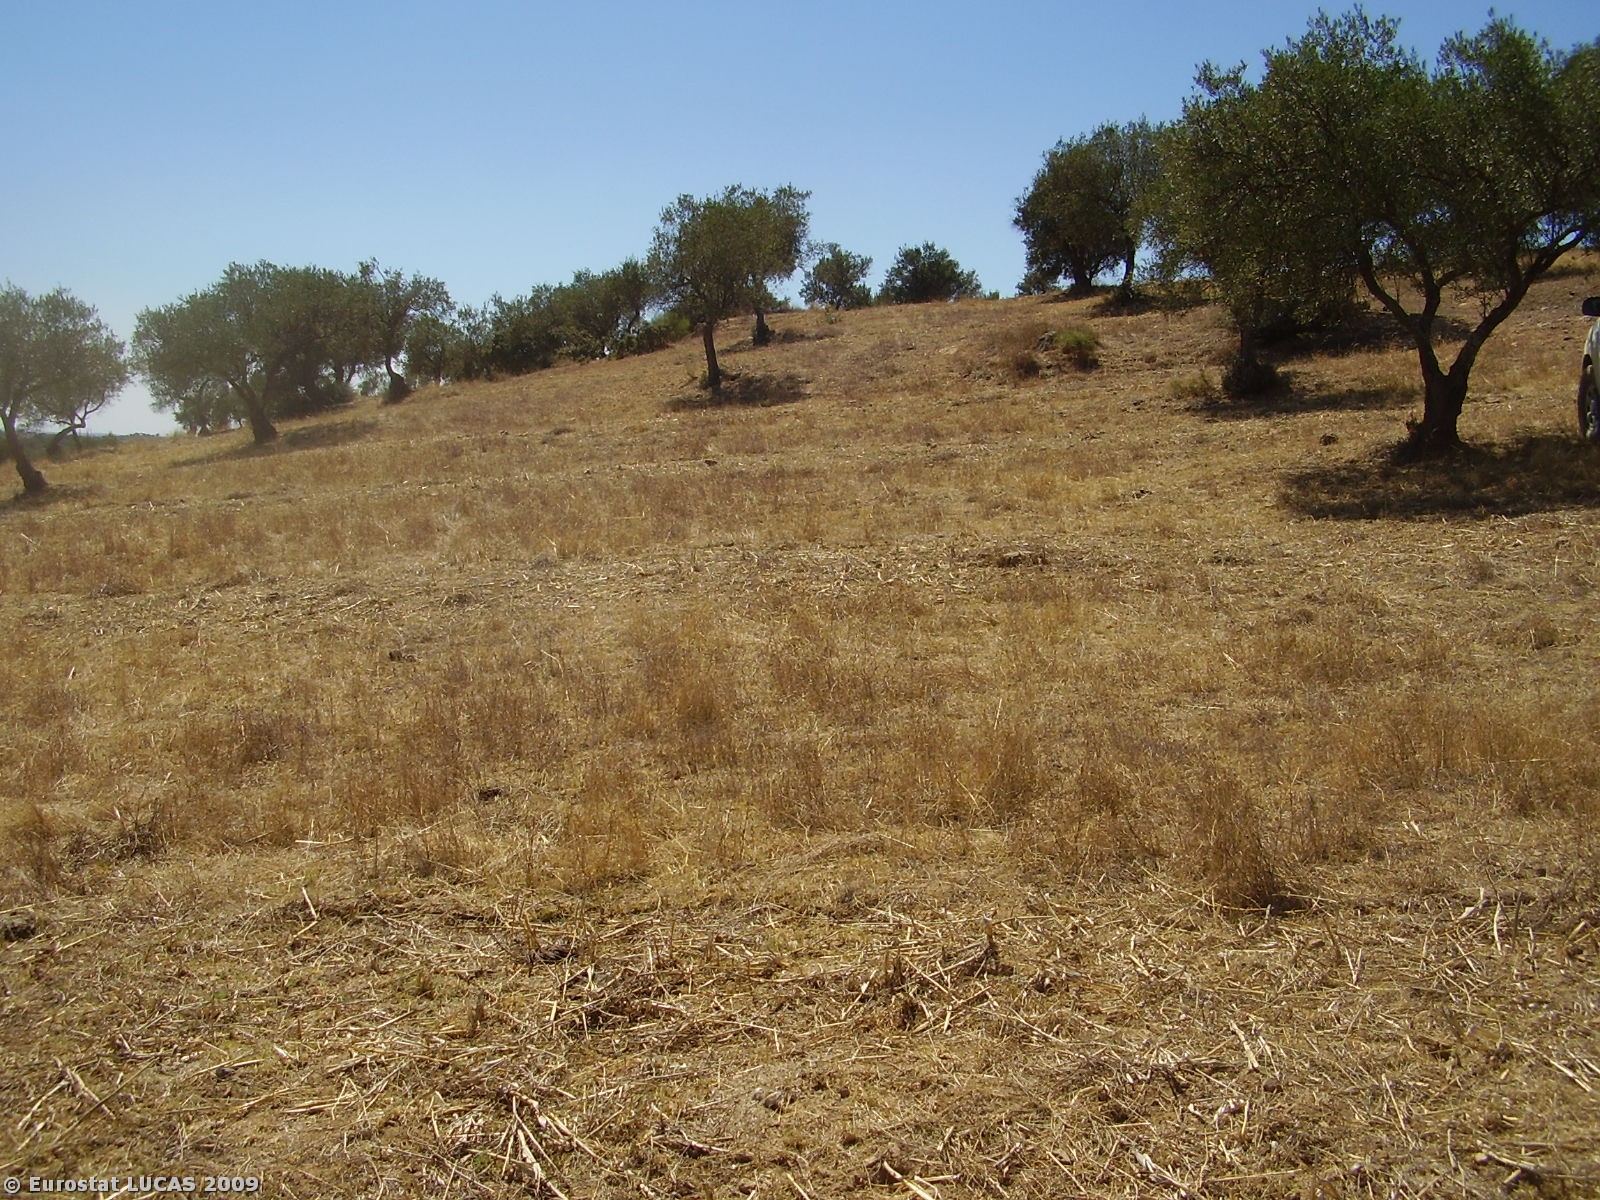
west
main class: Cropland
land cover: Olive groves
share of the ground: 25 - 50 %
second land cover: Spontaneously vegetated surfaces
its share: 25 - 50 %
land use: Agriculture (excluding fallow land and kitchen gardens)
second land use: Fallow land
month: July
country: PT
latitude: 37.8968
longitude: -7.5423
